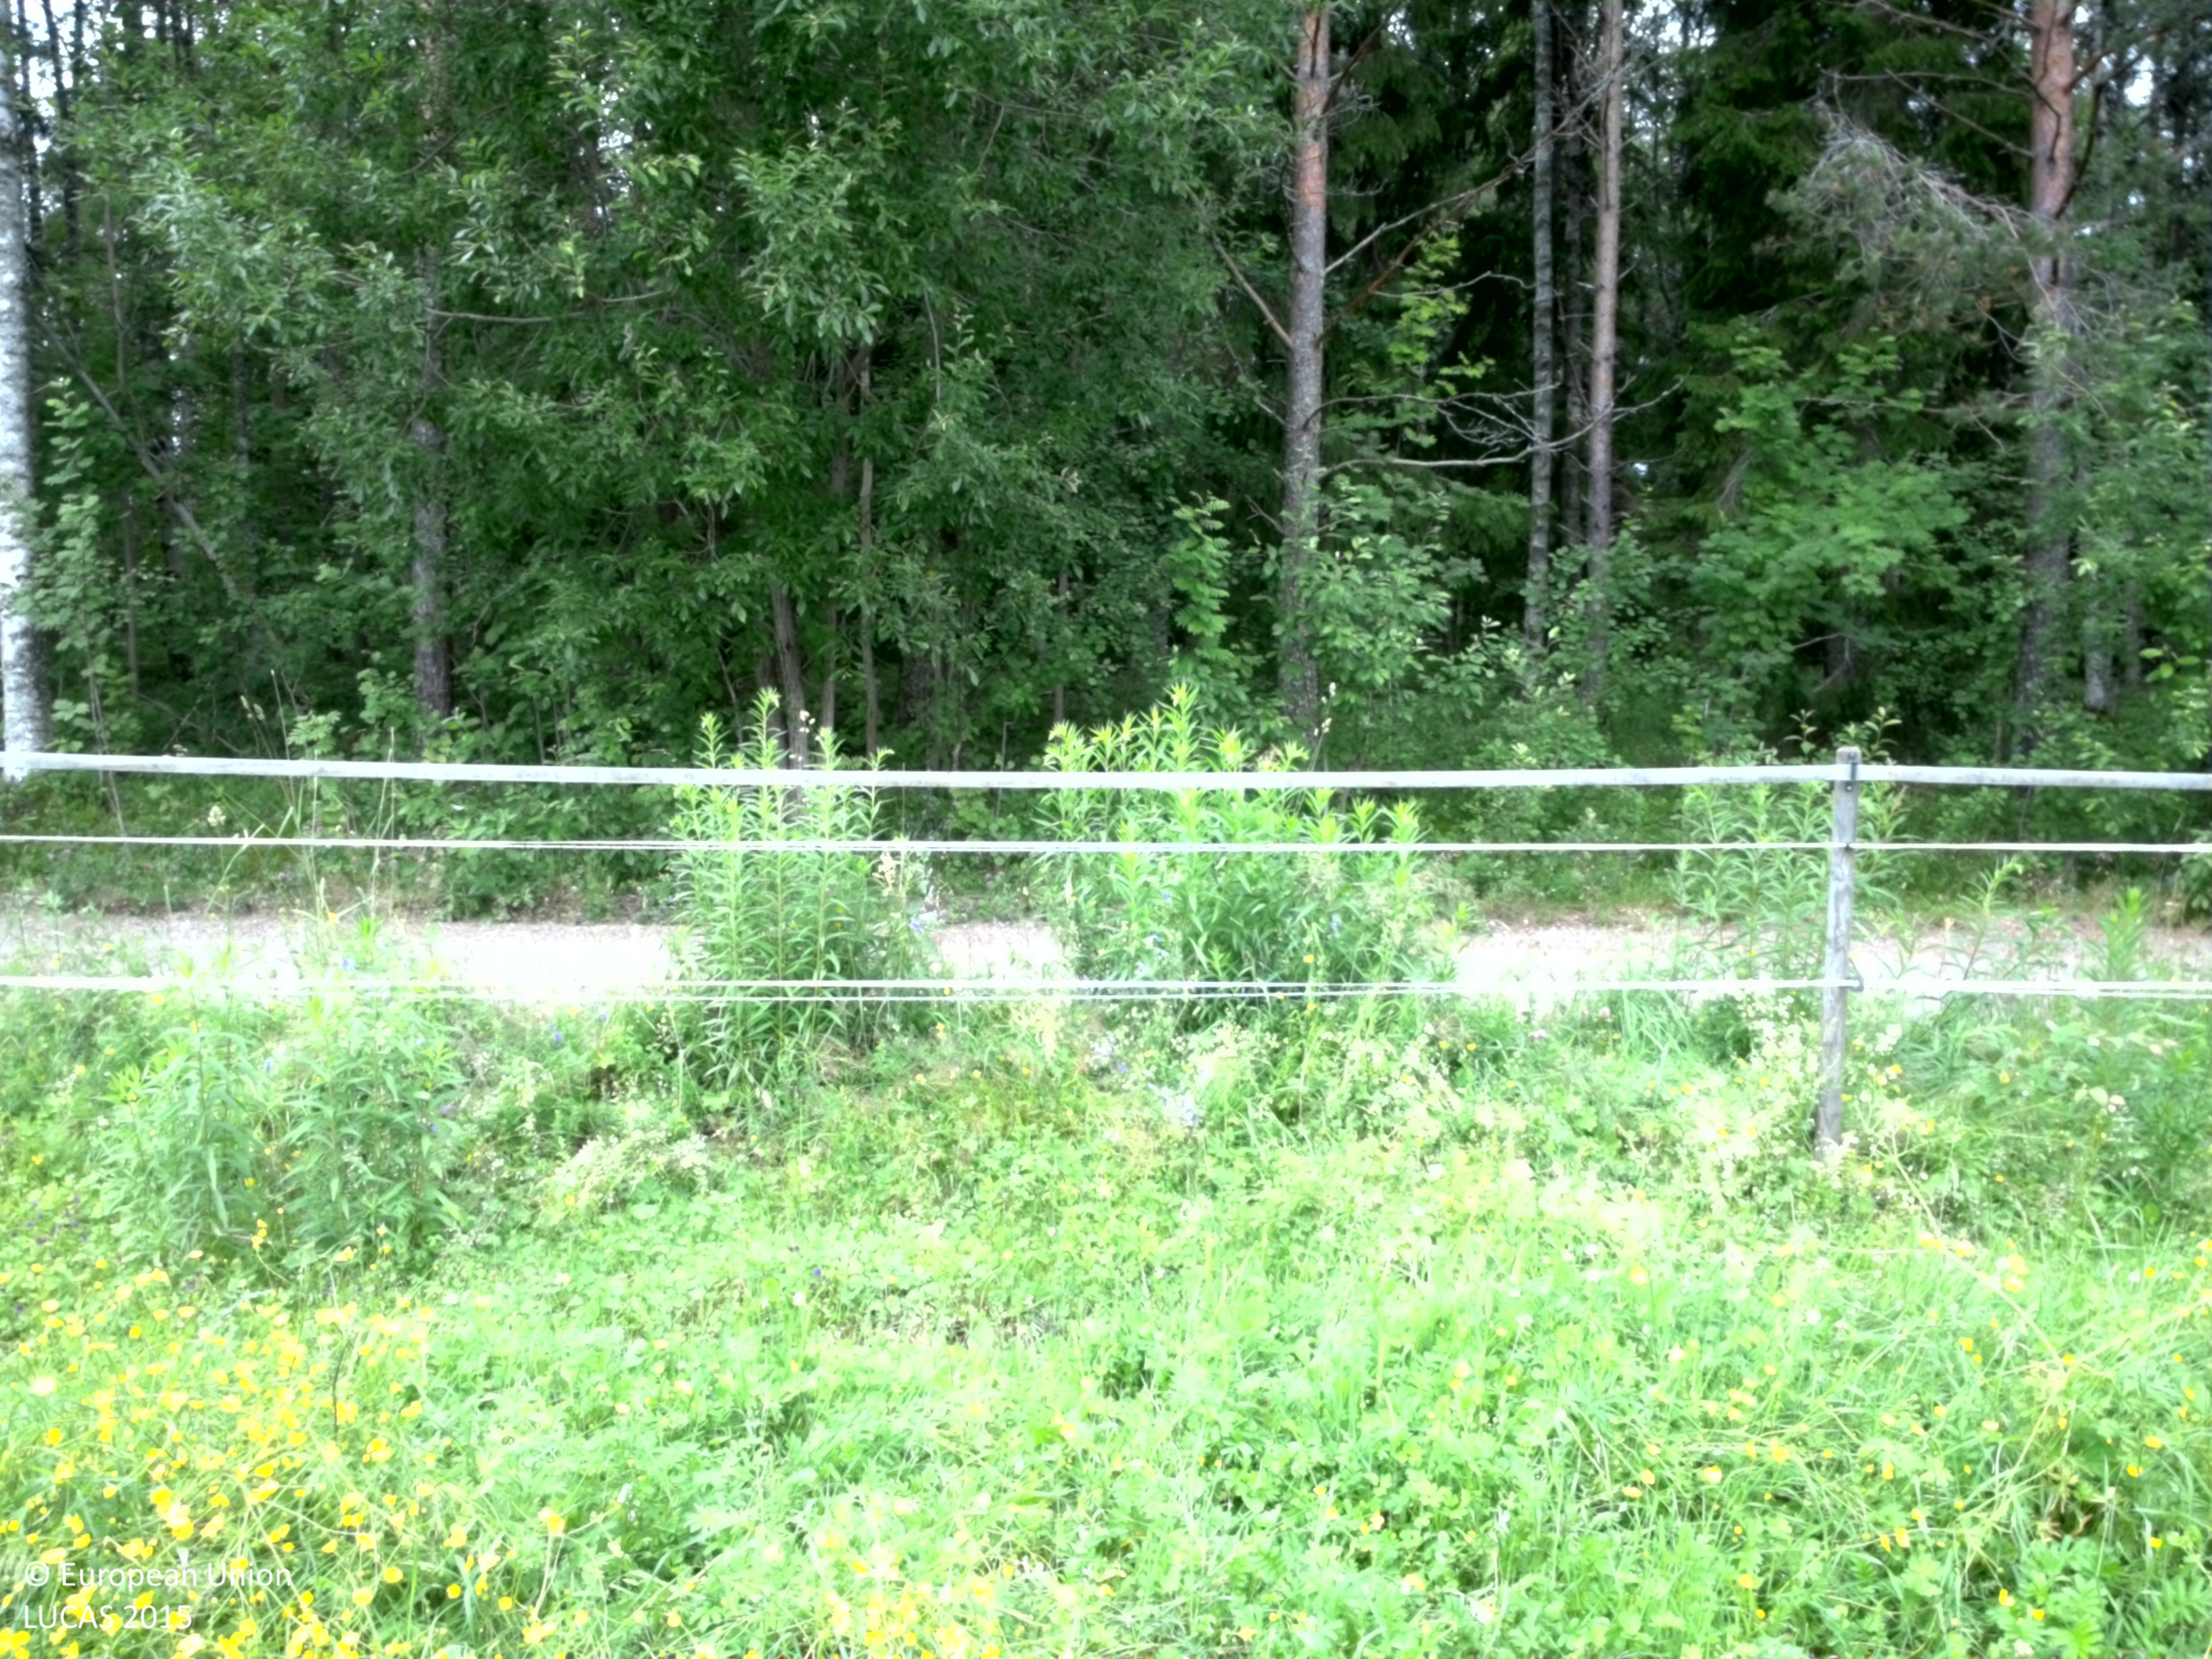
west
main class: Grassland
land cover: Grassland without tree/shrub cover
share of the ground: > 75 %
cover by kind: herbaceous plants 95 %, unconsolidated bare surface 5 %
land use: Agriculture (excluding fallow land and kitchen gardens)
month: July
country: SE
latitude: 59.7485
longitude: 14.4925
